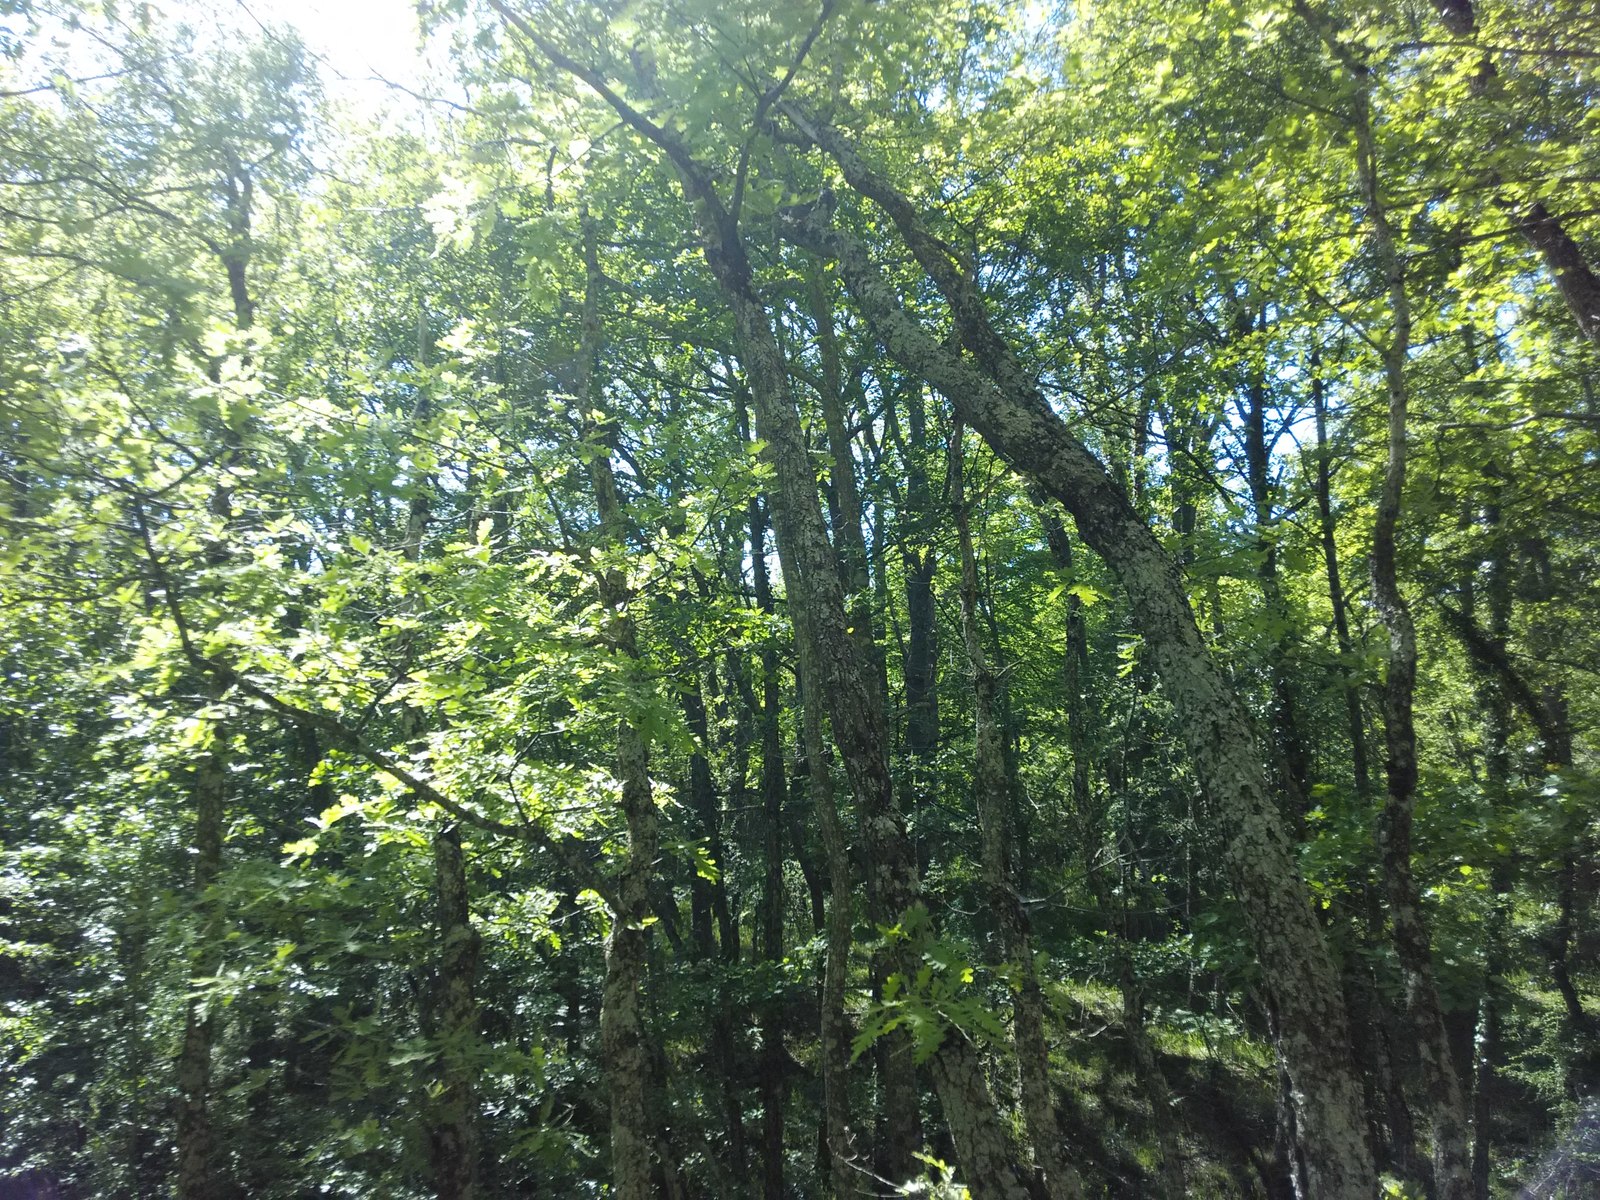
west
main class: Woodland
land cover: Broadleaved woodland
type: acidophilous oak and oak-birch forest
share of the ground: > 75 %
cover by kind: broadleaved forest trees 75 %, shrubs 15 %, herbaceous plants 10 %
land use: Forestry
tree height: > 5 m
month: May
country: ES
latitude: 42.6637
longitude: -2.4793
